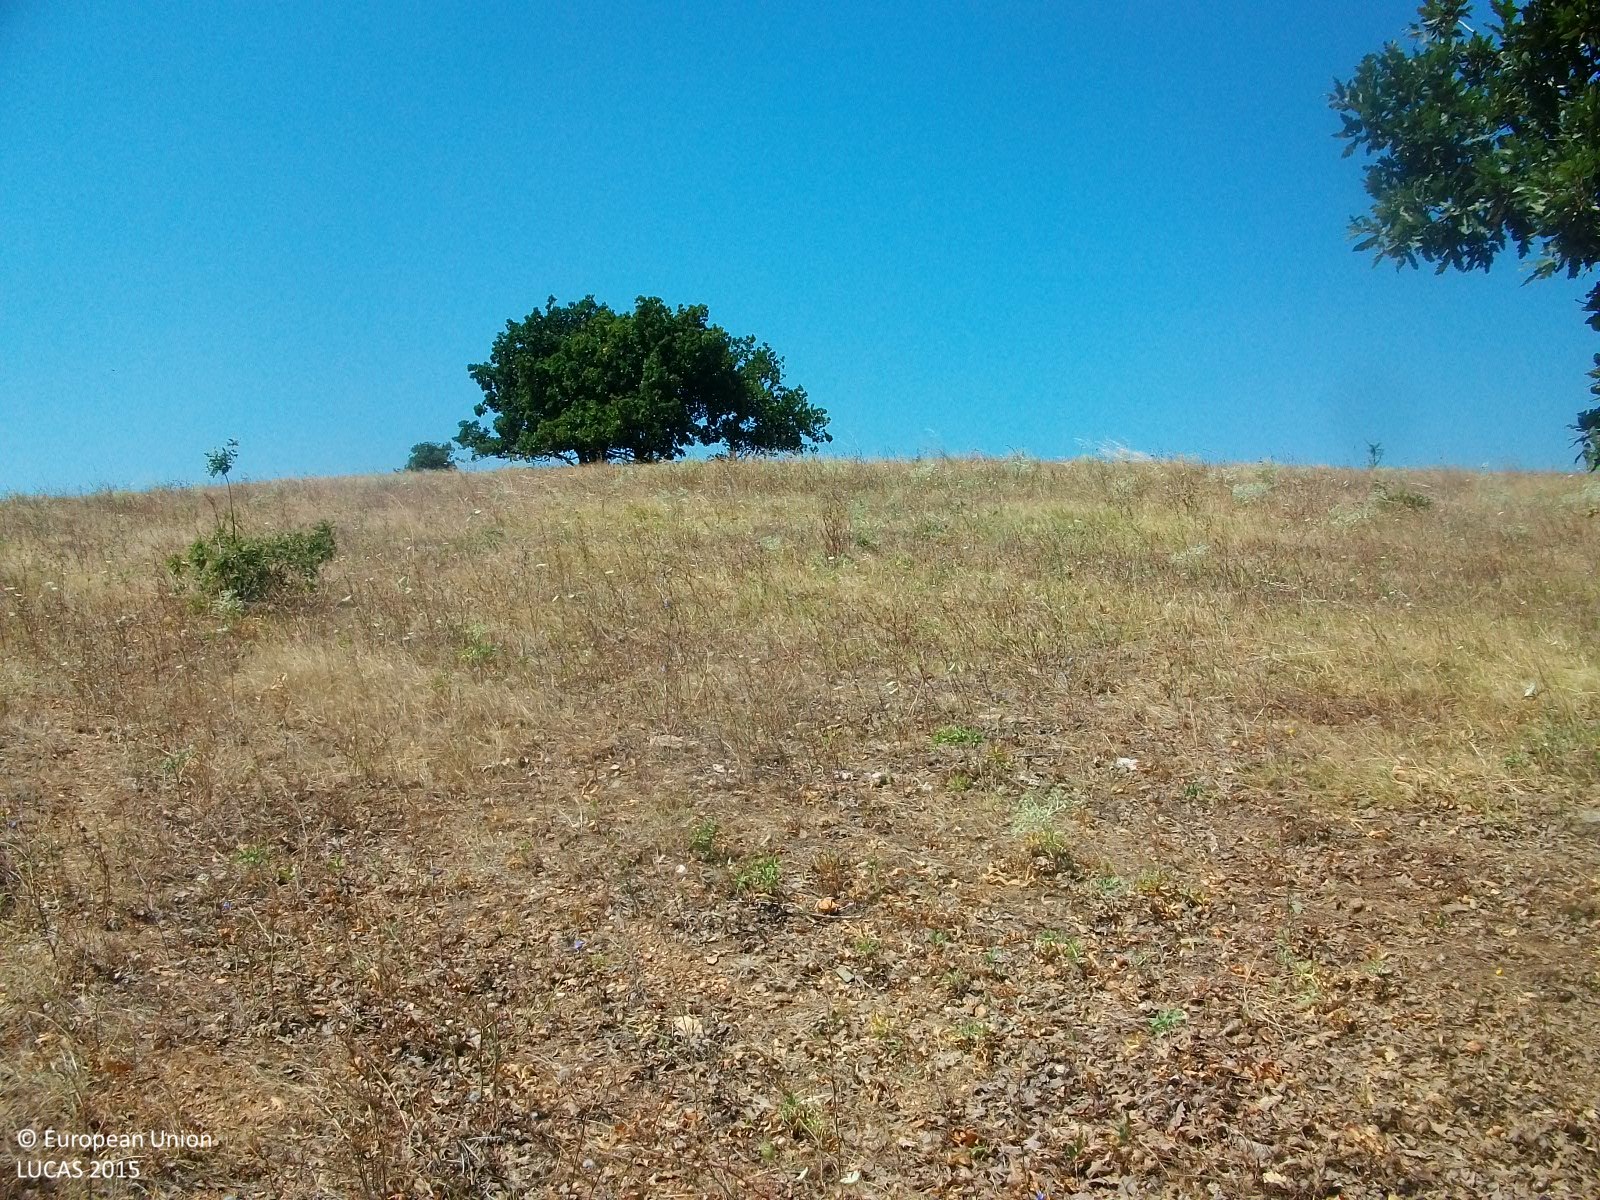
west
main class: Grassland
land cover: Grassland with sparse tree/shrub cover
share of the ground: > 75 %
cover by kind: herbaceous plants 85 %, shrubs 10 %, broadleaved forest trees 5 %
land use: Abandoned areas
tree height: > 5 m
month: August
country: GR
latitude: 41.2416
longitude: 26.2373
